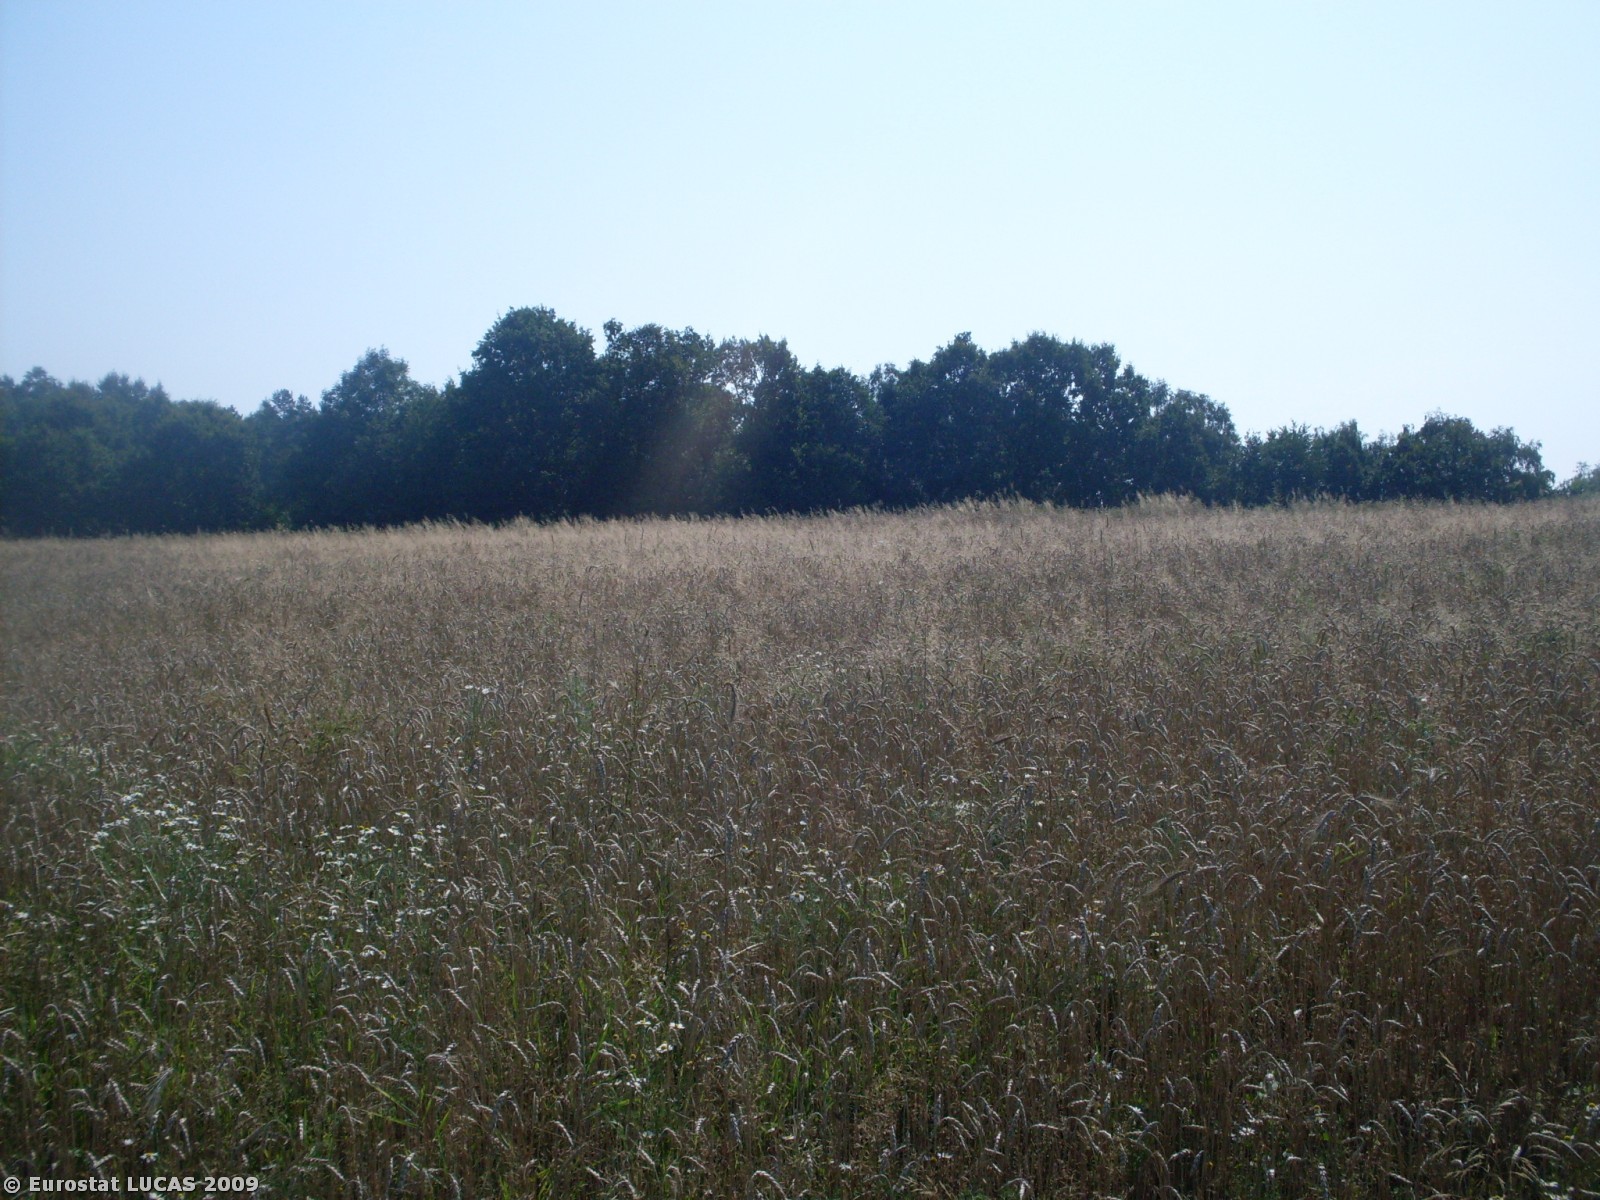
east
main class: Cropland
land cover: Common wheat
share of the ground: > 75 %
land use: Agriculture (excluding fallow land and kitchen gardens)
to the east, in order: Common wheat; Grass margins; Paved roads, cycling and walking lanes; Grass margins; Common wheat; Mixed woodland; Ditches and canals; Mixed woodland; Broadleaved woodland
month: August
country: PL
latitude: 49.9490
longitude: 20.5319
